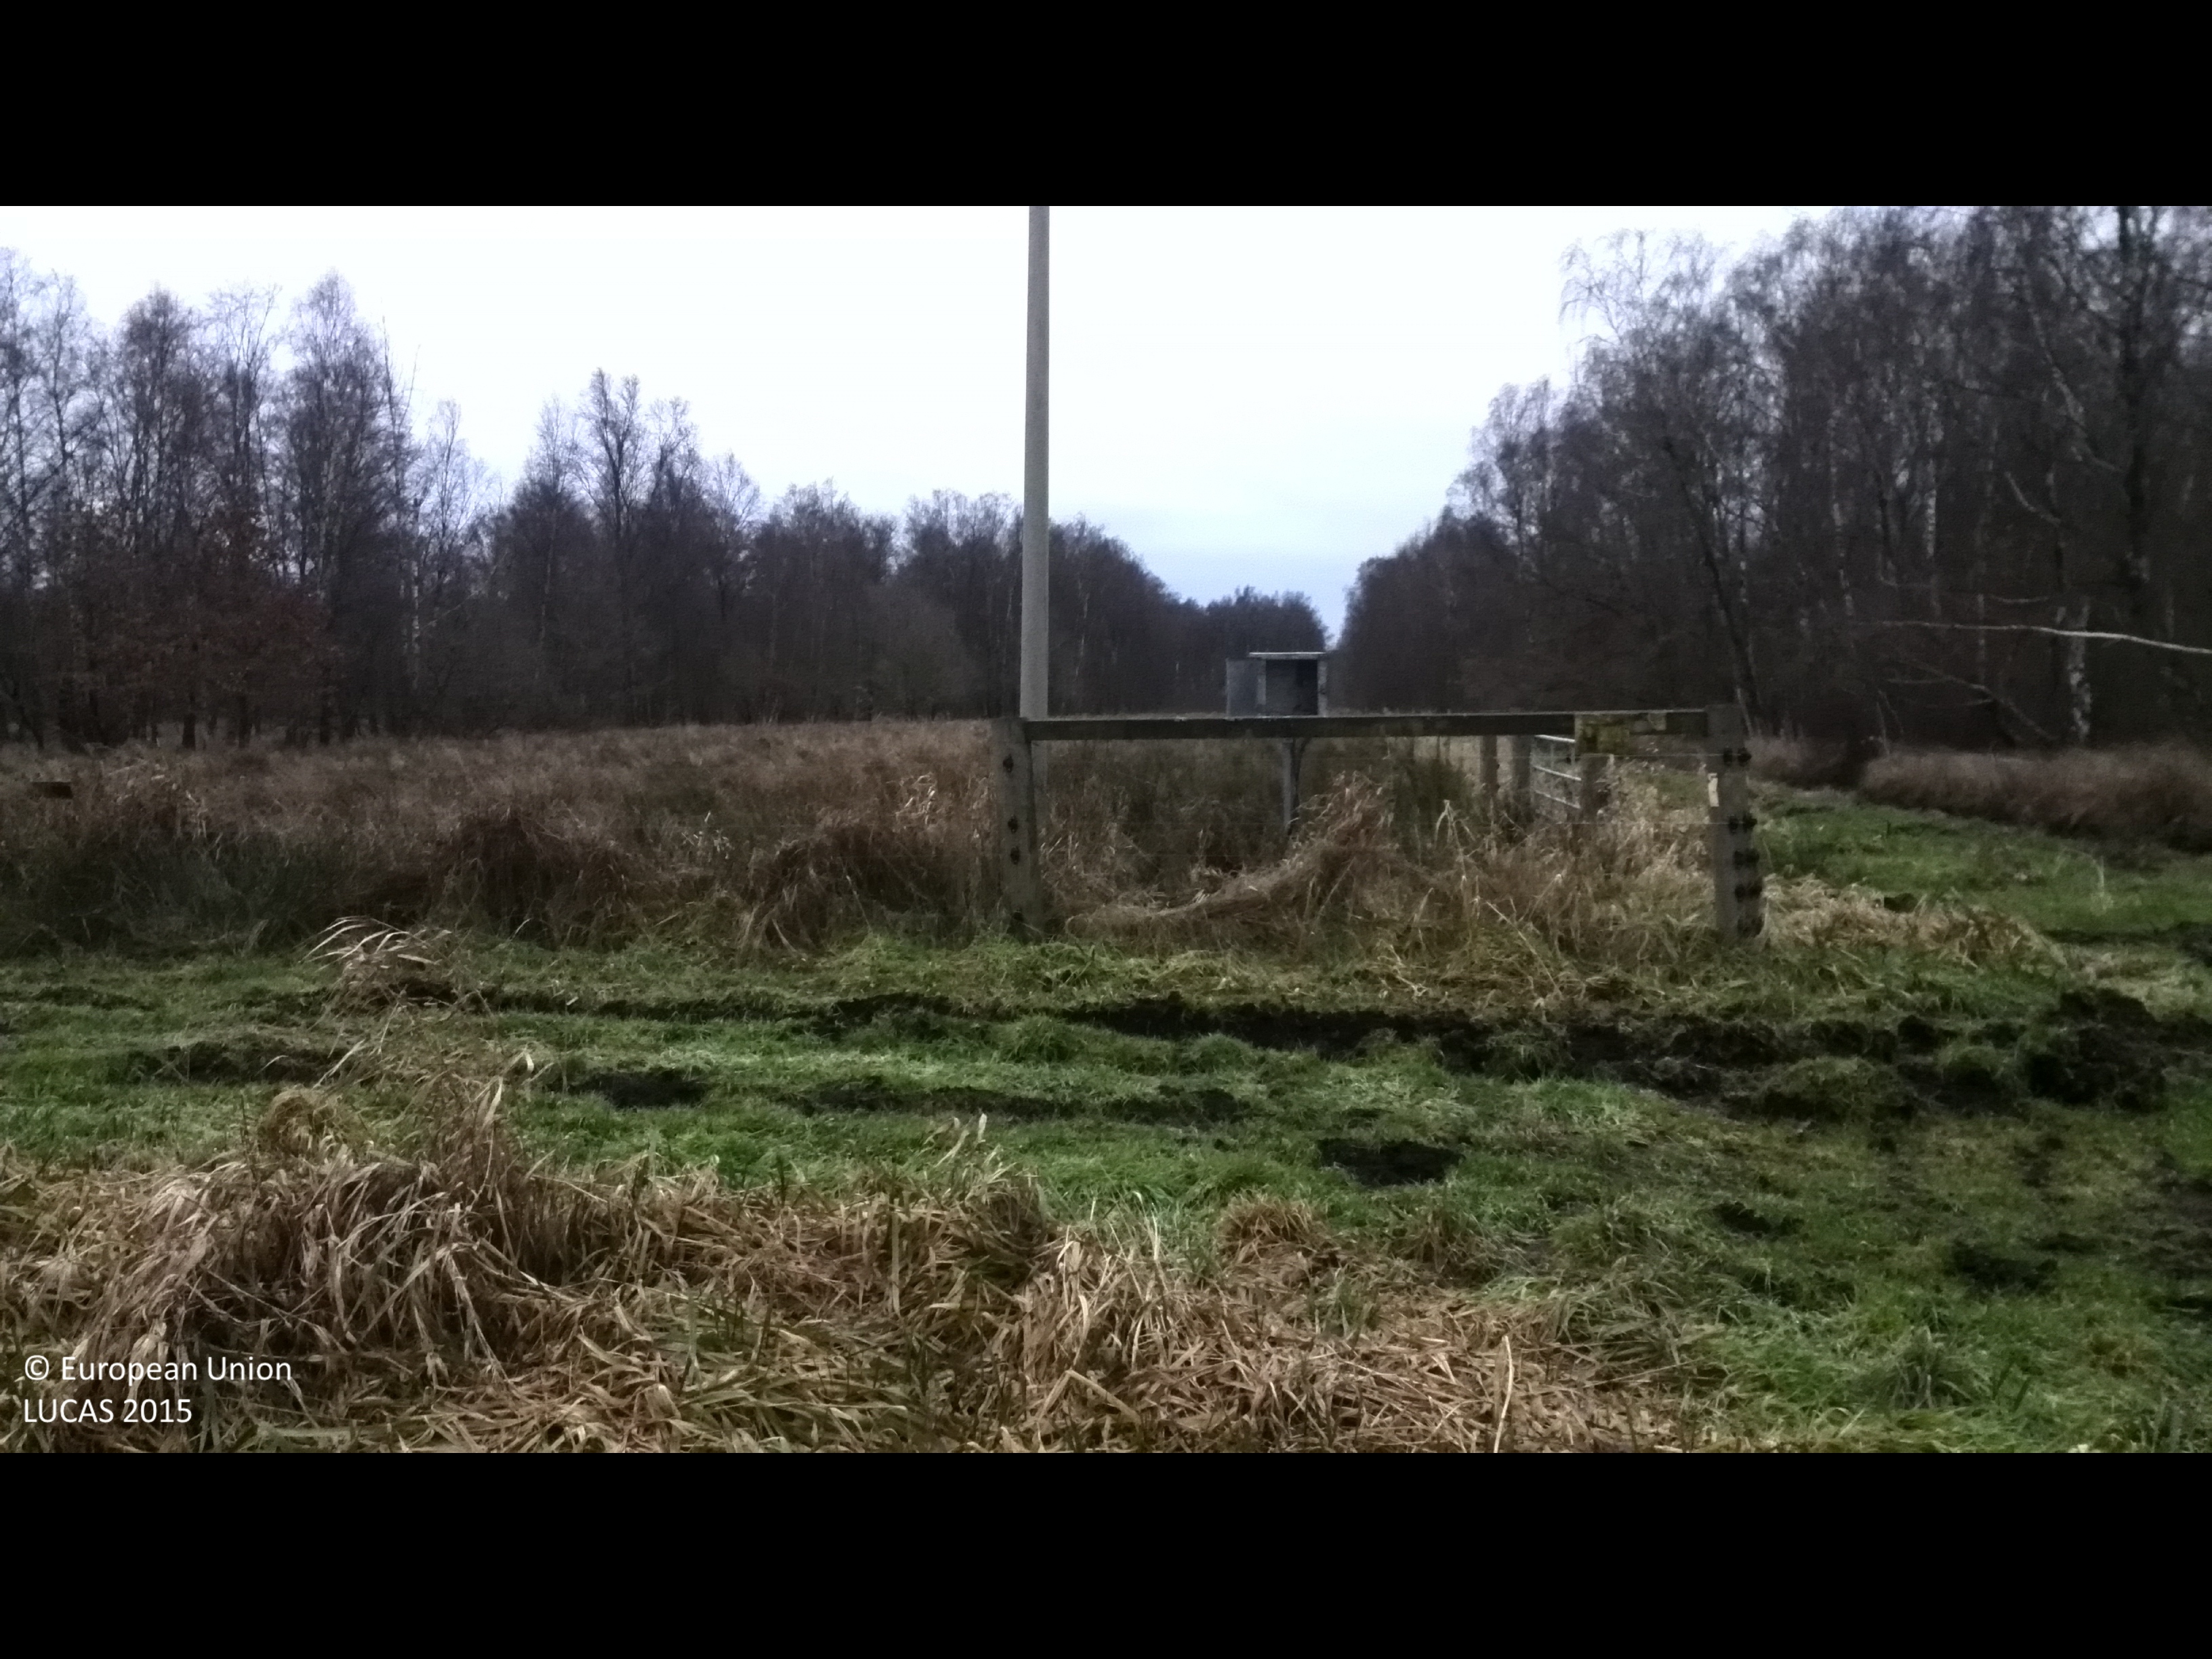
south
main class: Shrubland
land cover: Shrubland with sparse tree cover
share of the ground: > 75 %
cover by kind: shrubs 75 %, herbaceous plants 20 %, broadleaved forest trees 5 %
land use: Semi-natural and natural areas not in use
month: January
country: DE
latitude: 53.4917
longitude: 9.8343
